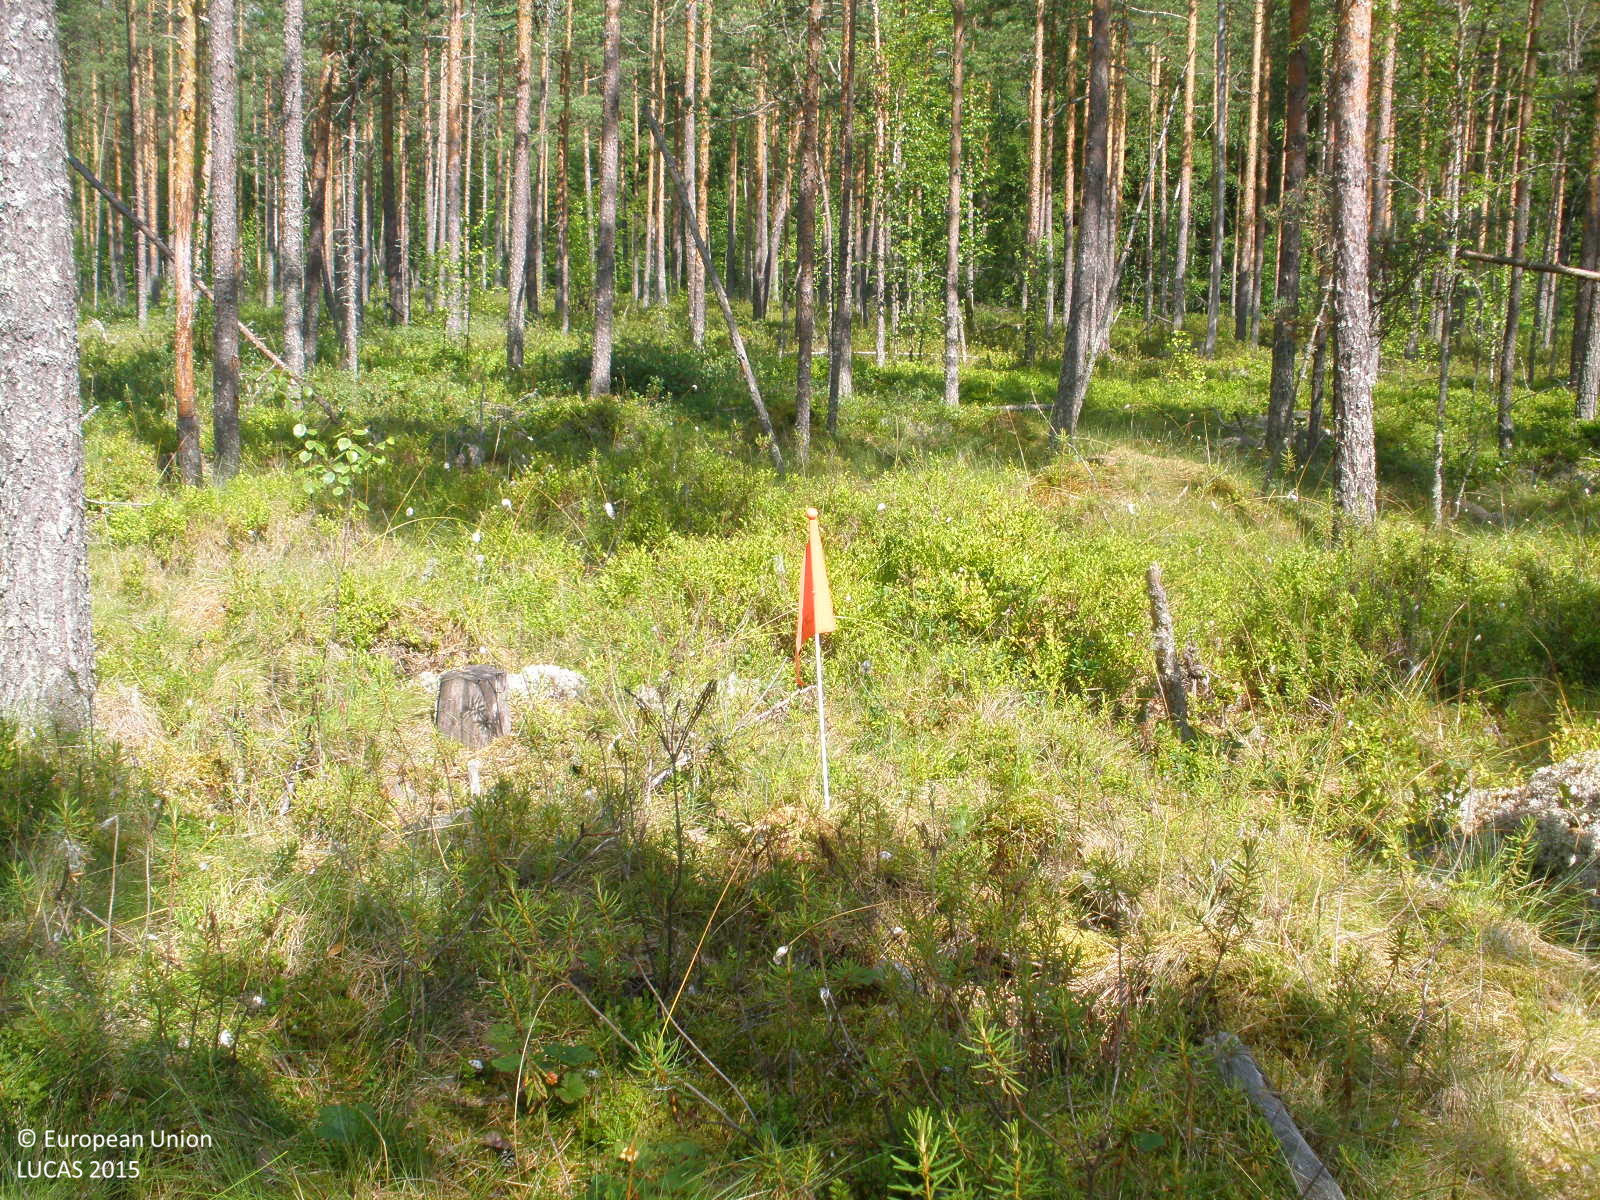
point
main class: Woodland
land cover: Pine dominated coniferous woodland
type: boreal forest
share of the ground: 50 - 75 %
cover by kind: coniferous forest trees 70 %, lichens and mosses 15 %, shrubs 10 %, herbaceous plants 5 %
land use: Forestry
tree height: > 5 m
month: July
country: FI
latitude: 61.5265
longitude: 24.7894
